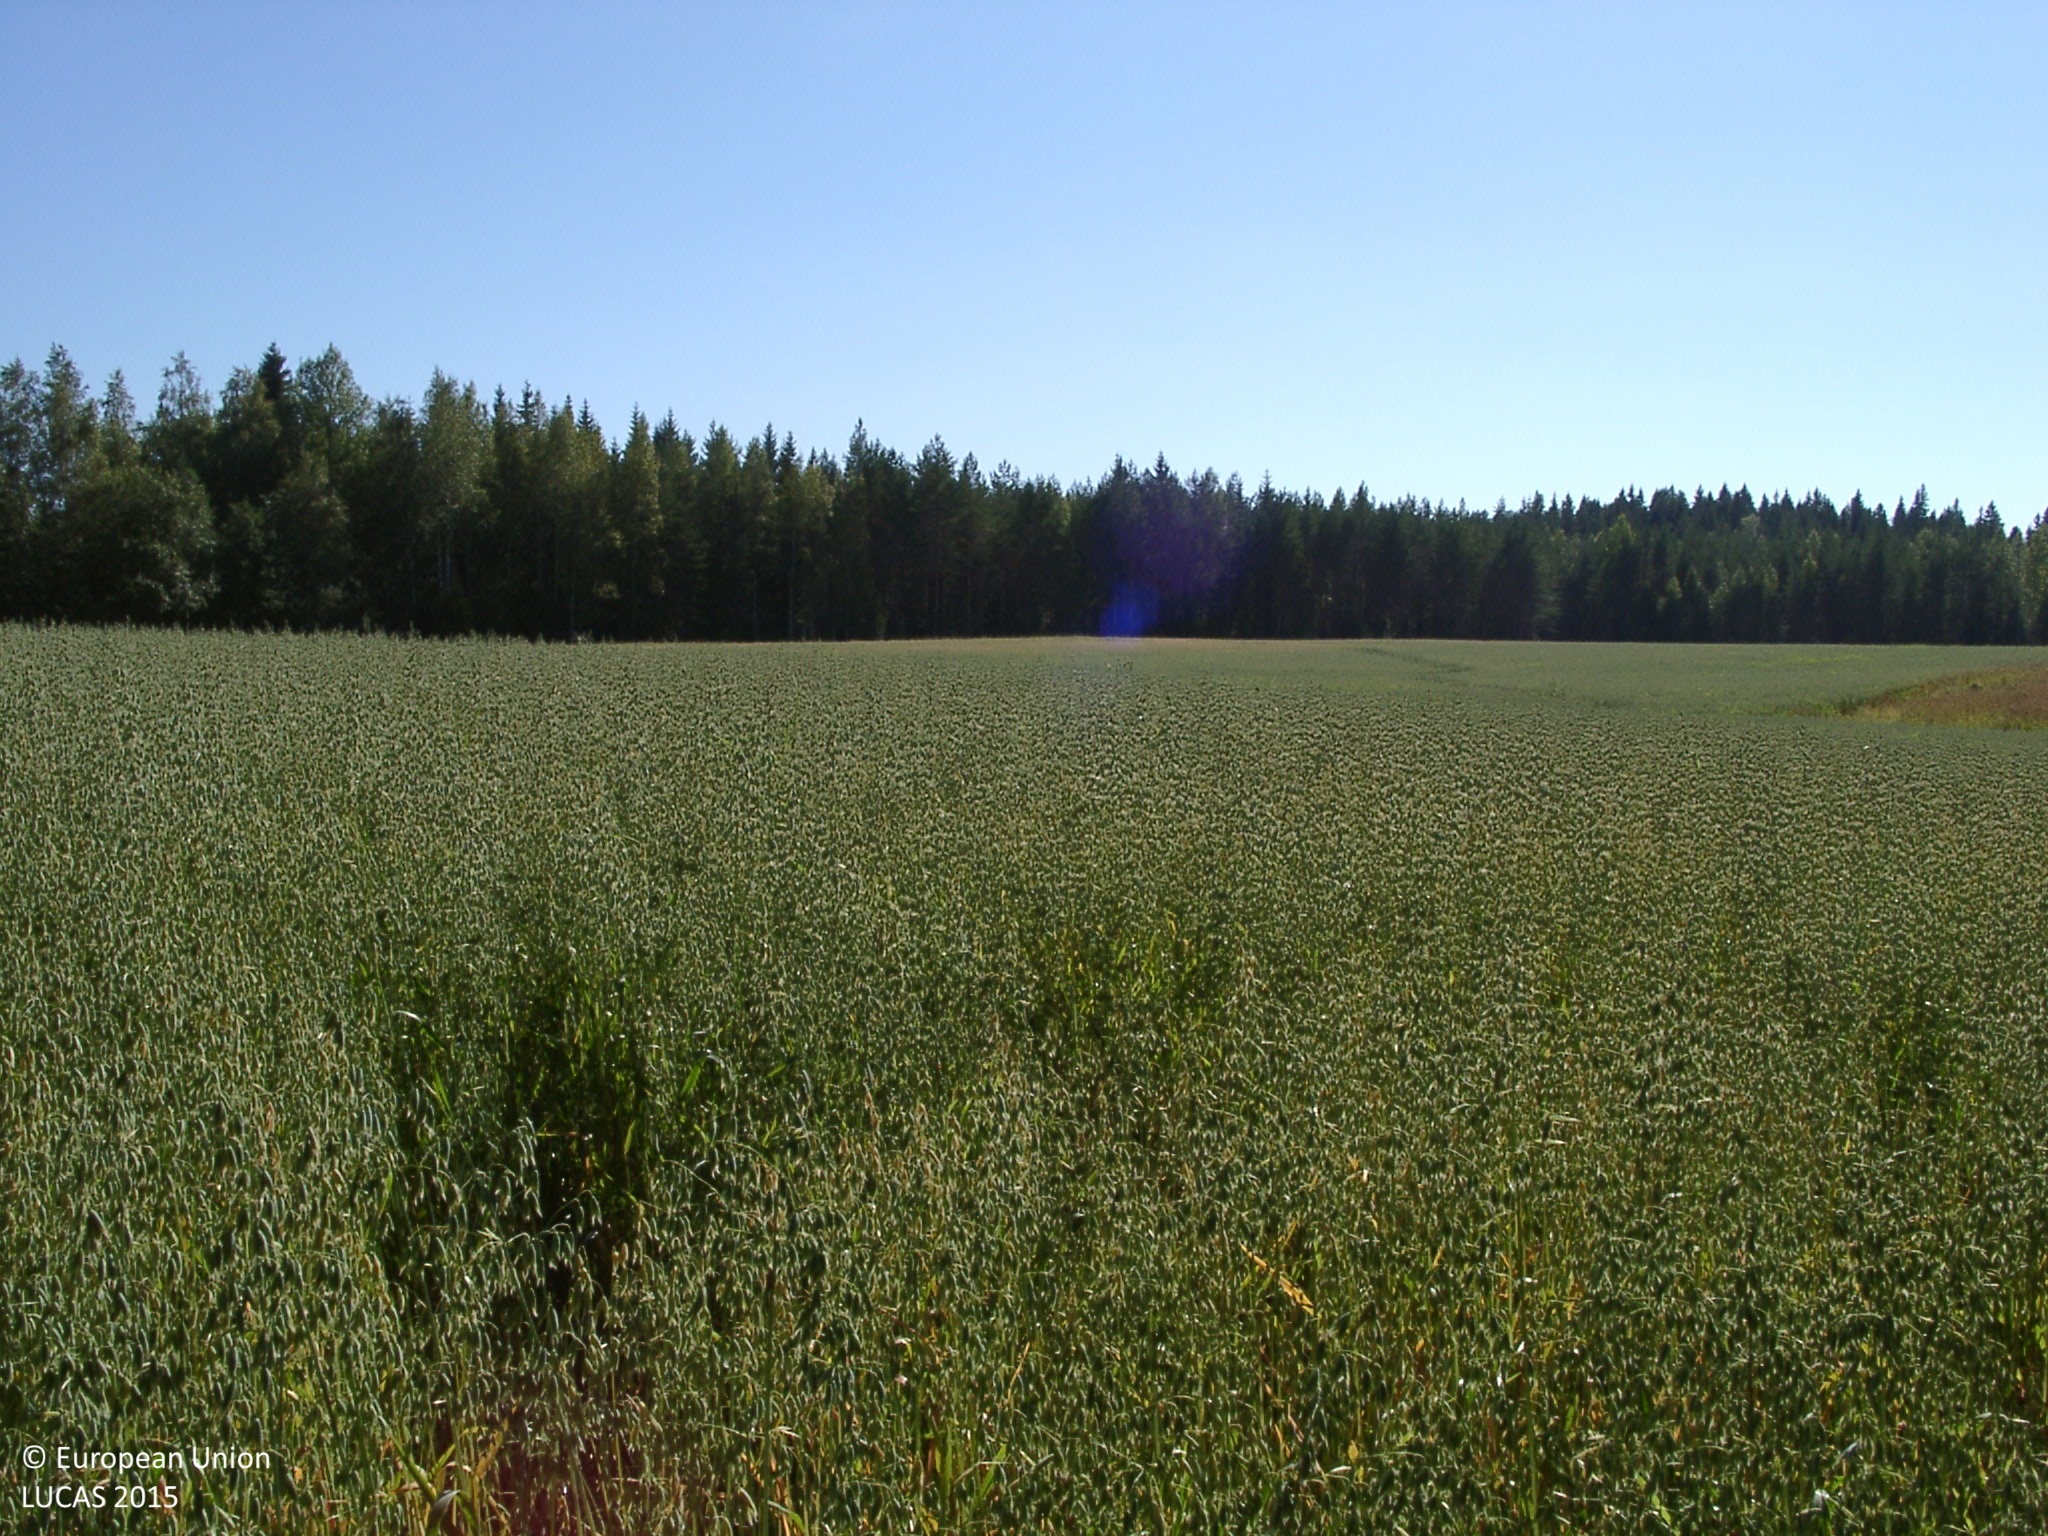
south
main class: Cropland
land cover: Oats
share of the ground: > 75 %
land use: Agriculture (excluding fallow land and kitchen gardens)
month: August
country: FI
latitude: 61.9902
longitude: 24.9347
